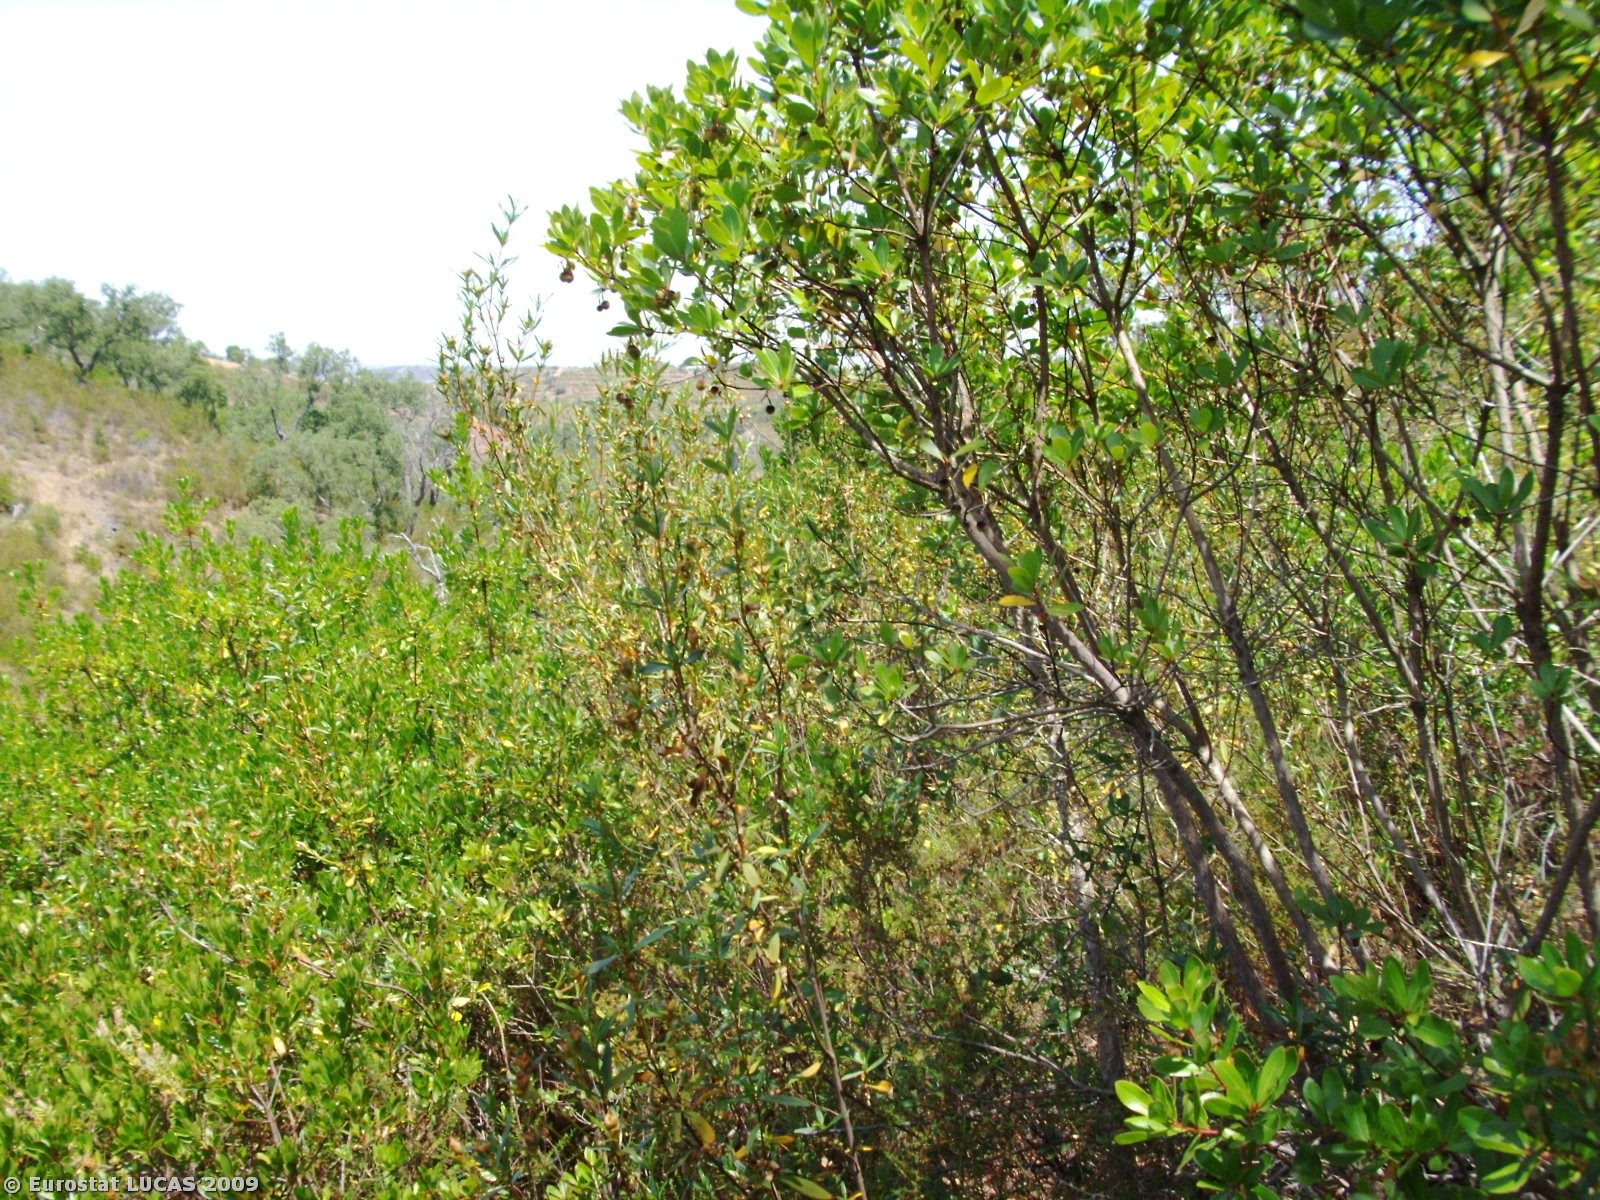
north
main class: Woodland
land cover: Broadleaved woodland
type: broadleaved evergreen forest
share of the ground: > 75 %
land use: Unused
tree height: > 5 m
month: June
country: PT
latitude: 37.4684
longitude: -8.5188
